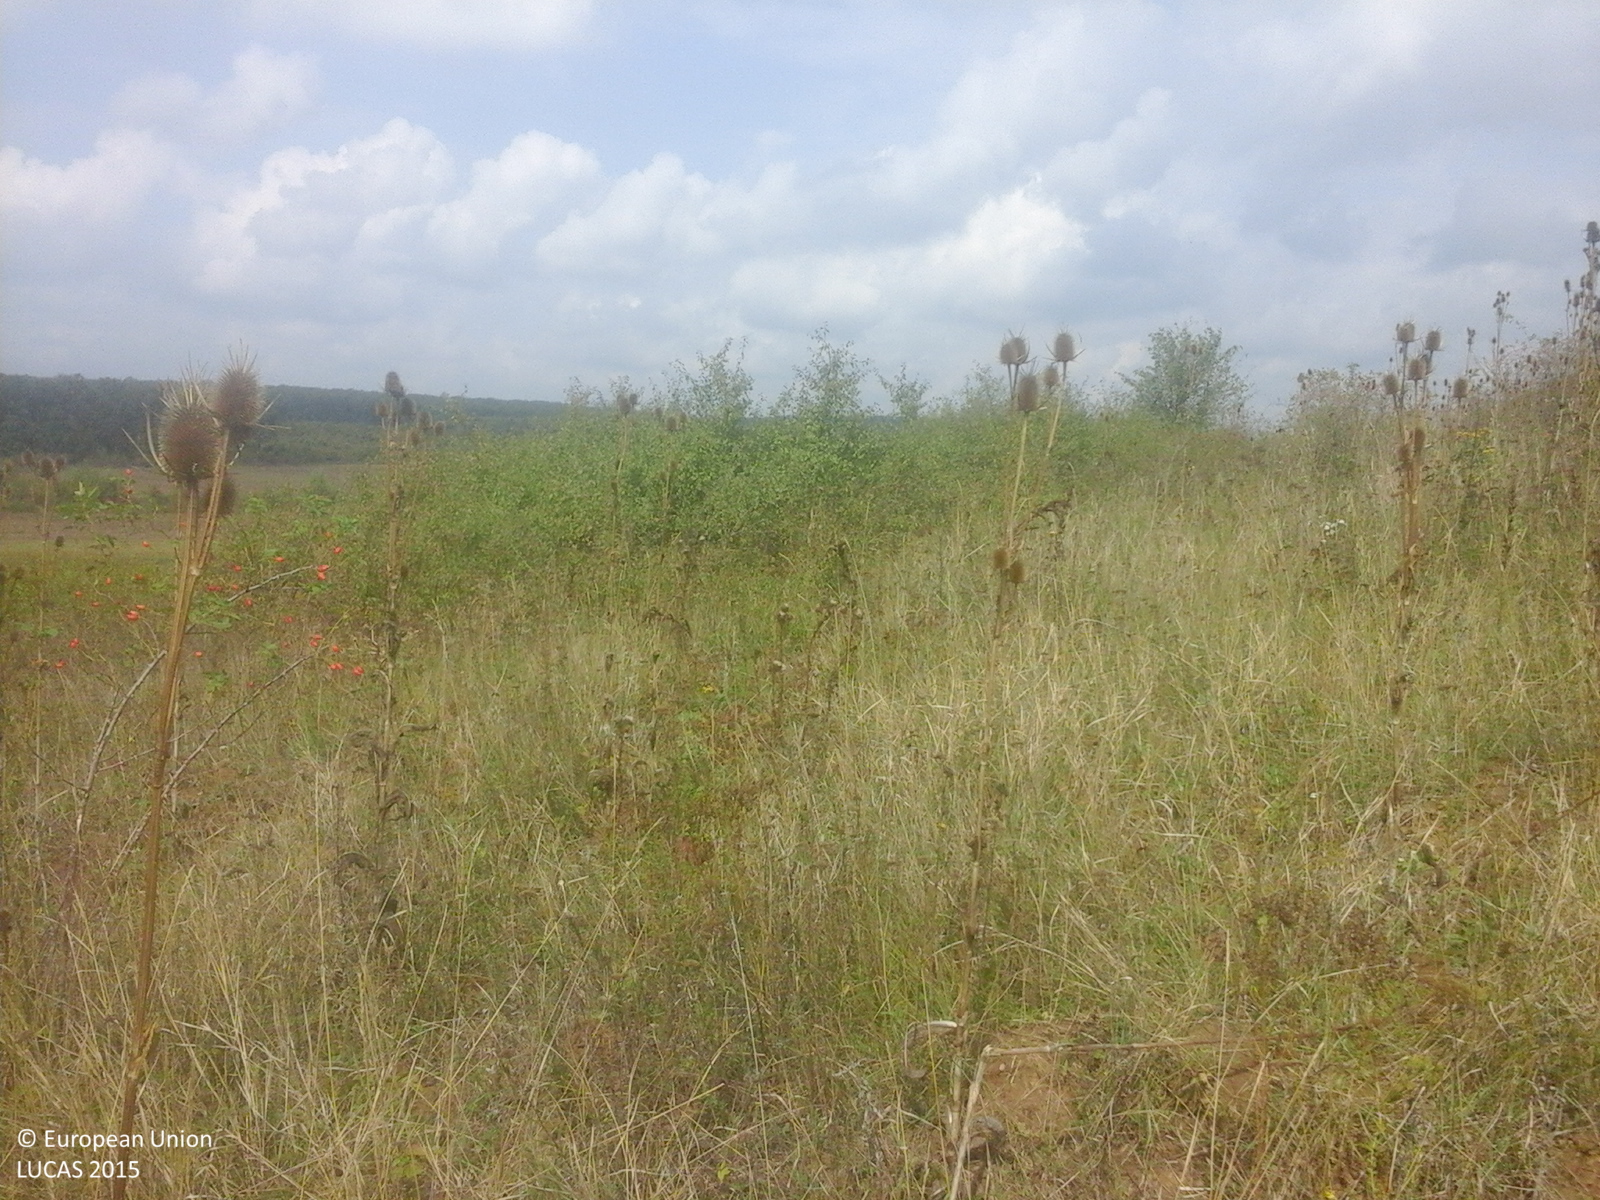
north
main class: Grassland
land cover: Spontaneously vegetated surfaces
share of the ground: > 75 %
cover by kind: herbaceous plants 100 %
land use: Fallow land
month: September
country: RO
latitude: 46.8444
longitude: 21.9390
